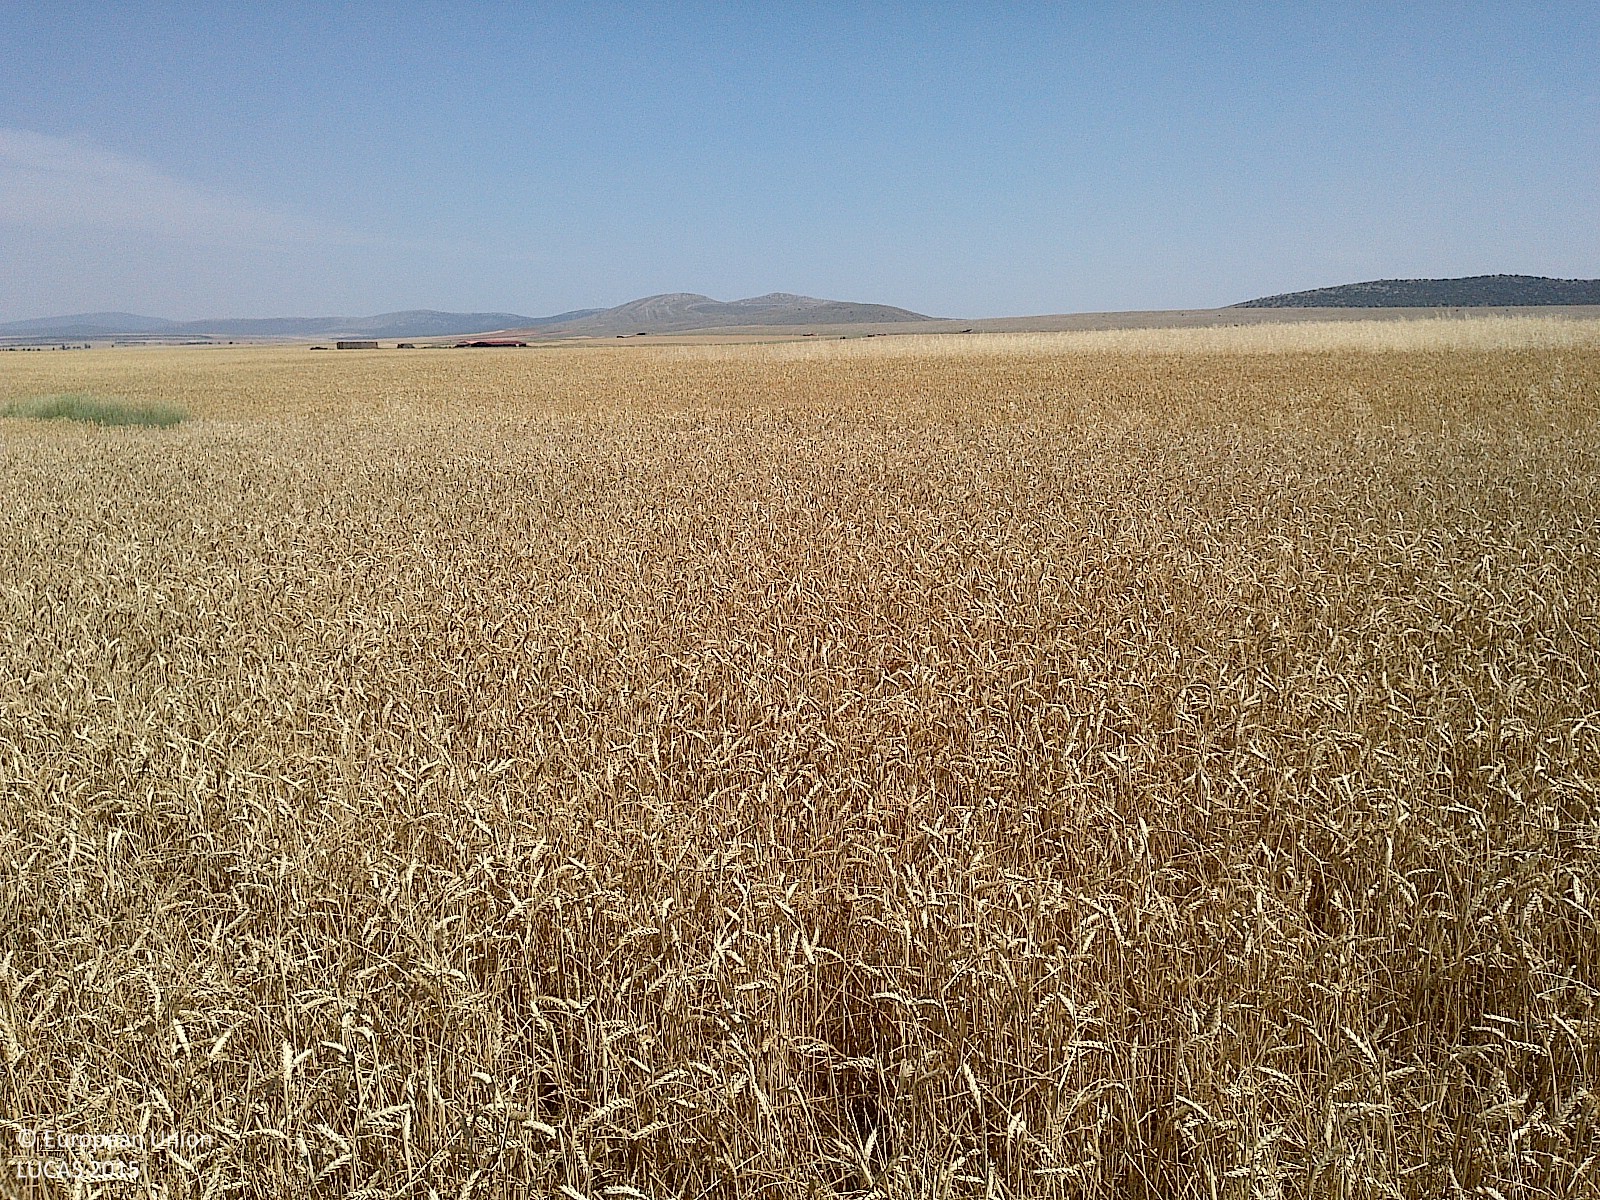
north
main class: Cropland
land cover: Common wheat
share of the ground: > 75 %
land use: Agriculture (excluding fallow land and kitchen gardens)
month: July
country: ES
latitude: 41.5928
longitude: -2.1371
